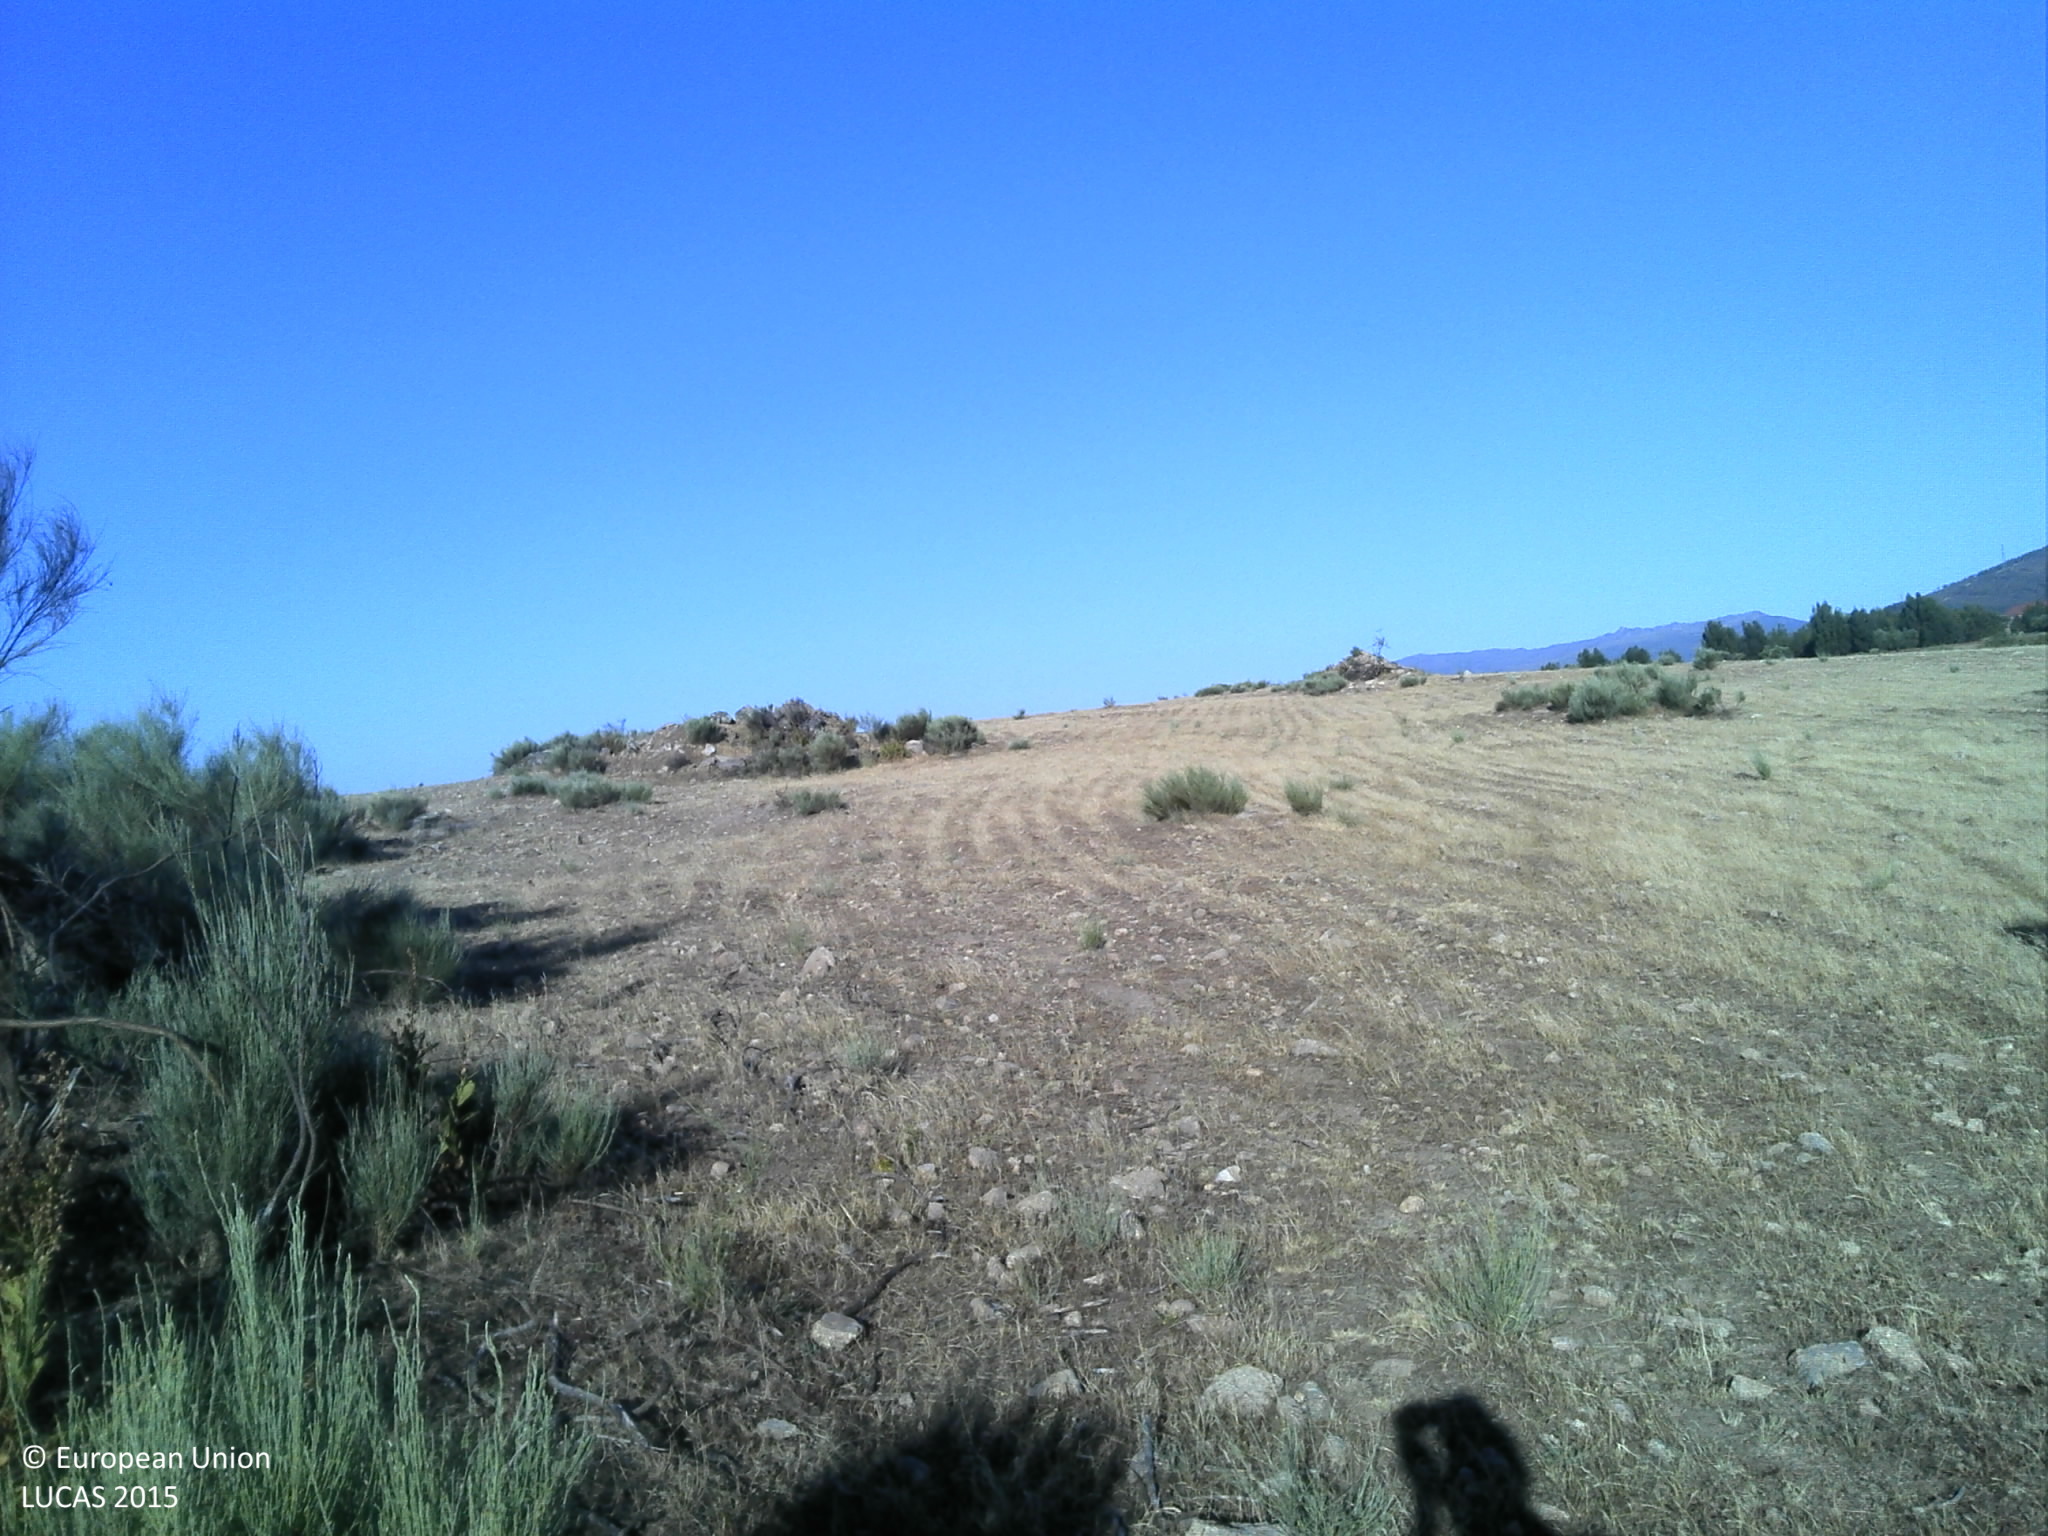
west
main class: Shrubland
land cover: Shrubland without tree cover
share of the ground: 50 - 75 %
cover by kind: shrubs 70 %, herbaceous plants 10 %, unconsolidated bare surface 10 %
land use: Agriculture (excluding fallow land and kitchen gardens)
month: June
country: PT
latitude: 40.1131
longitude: -7.3356
